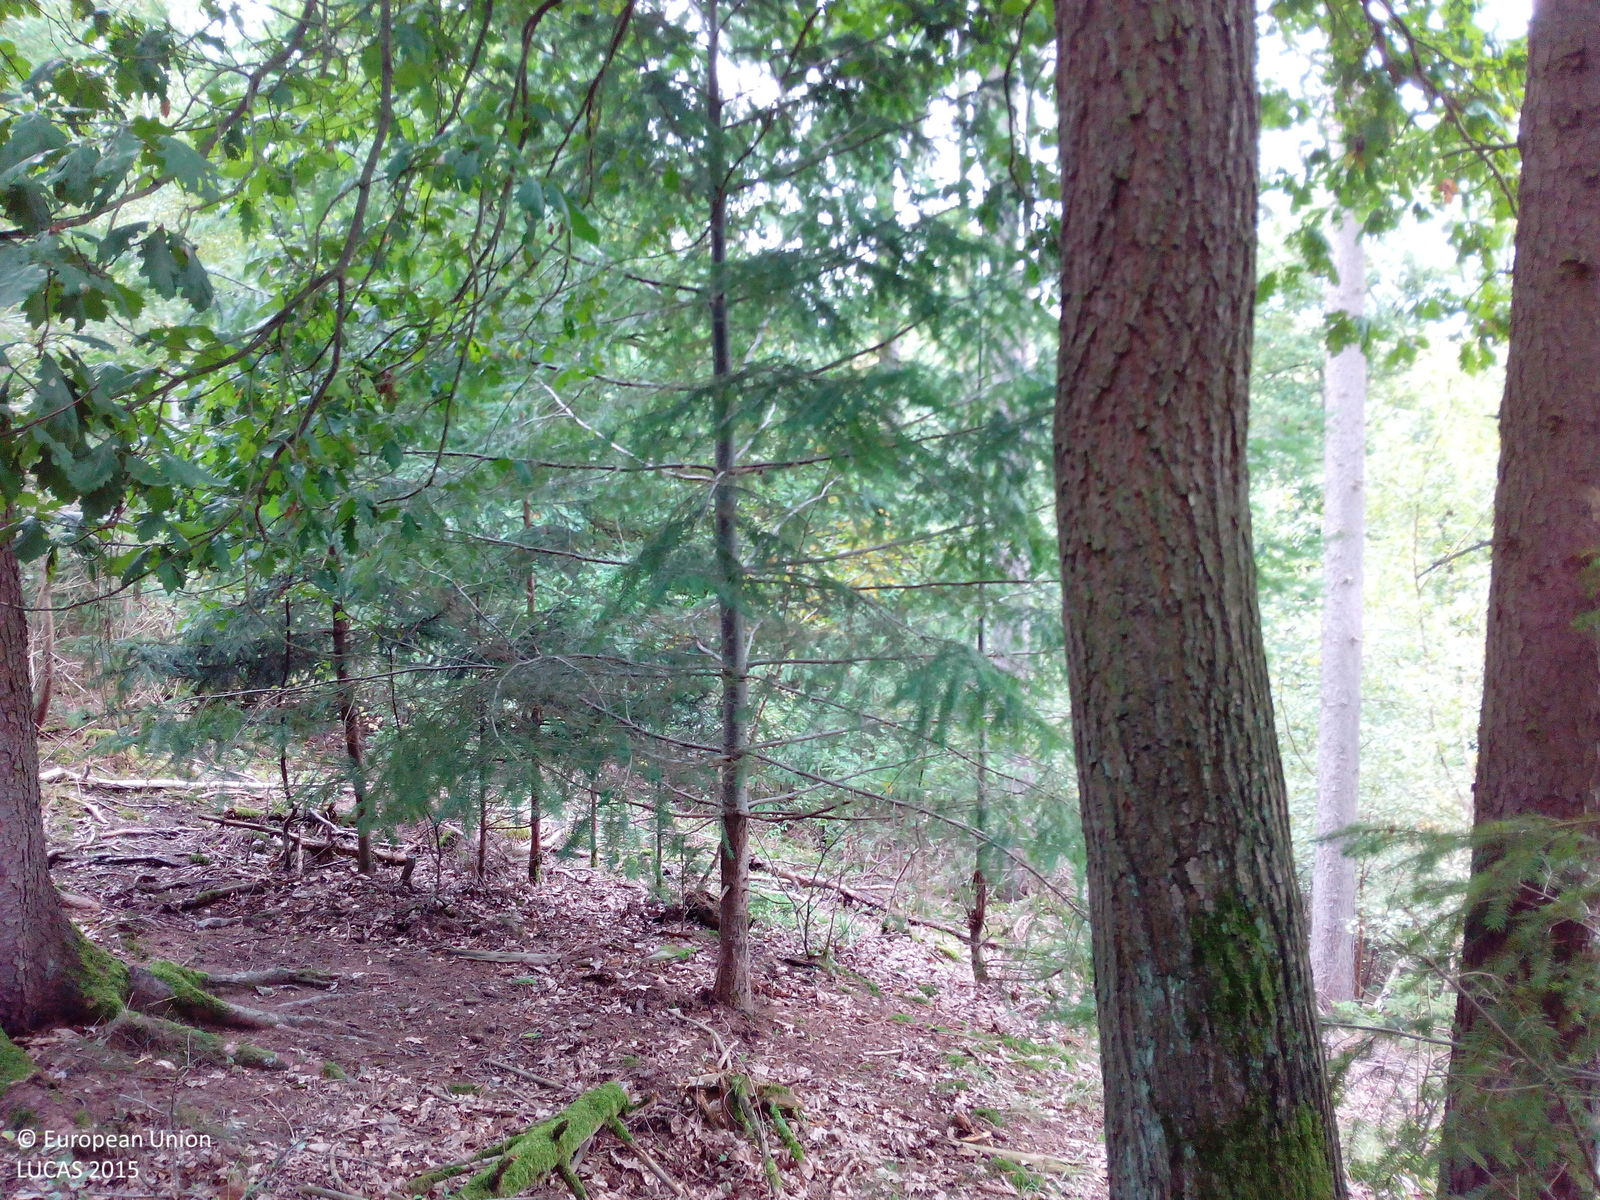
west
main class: Woodland
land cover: Spruce dominated mixed woodland
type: hemiboreal forest and nemoral coniferous forest and mixed broadleaved-coniferous forest
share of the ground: 50 - 75 %
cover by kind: coniferous forest trees 35 %, broadleaved forest trees 25 %, herbaceous plants 20 %, lichens and mosses 10 %, unconsolidated bare surface 10 %
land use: Forestry
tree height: > 5 m
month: September
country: DE
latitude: 50.4455
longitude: 8.6062
